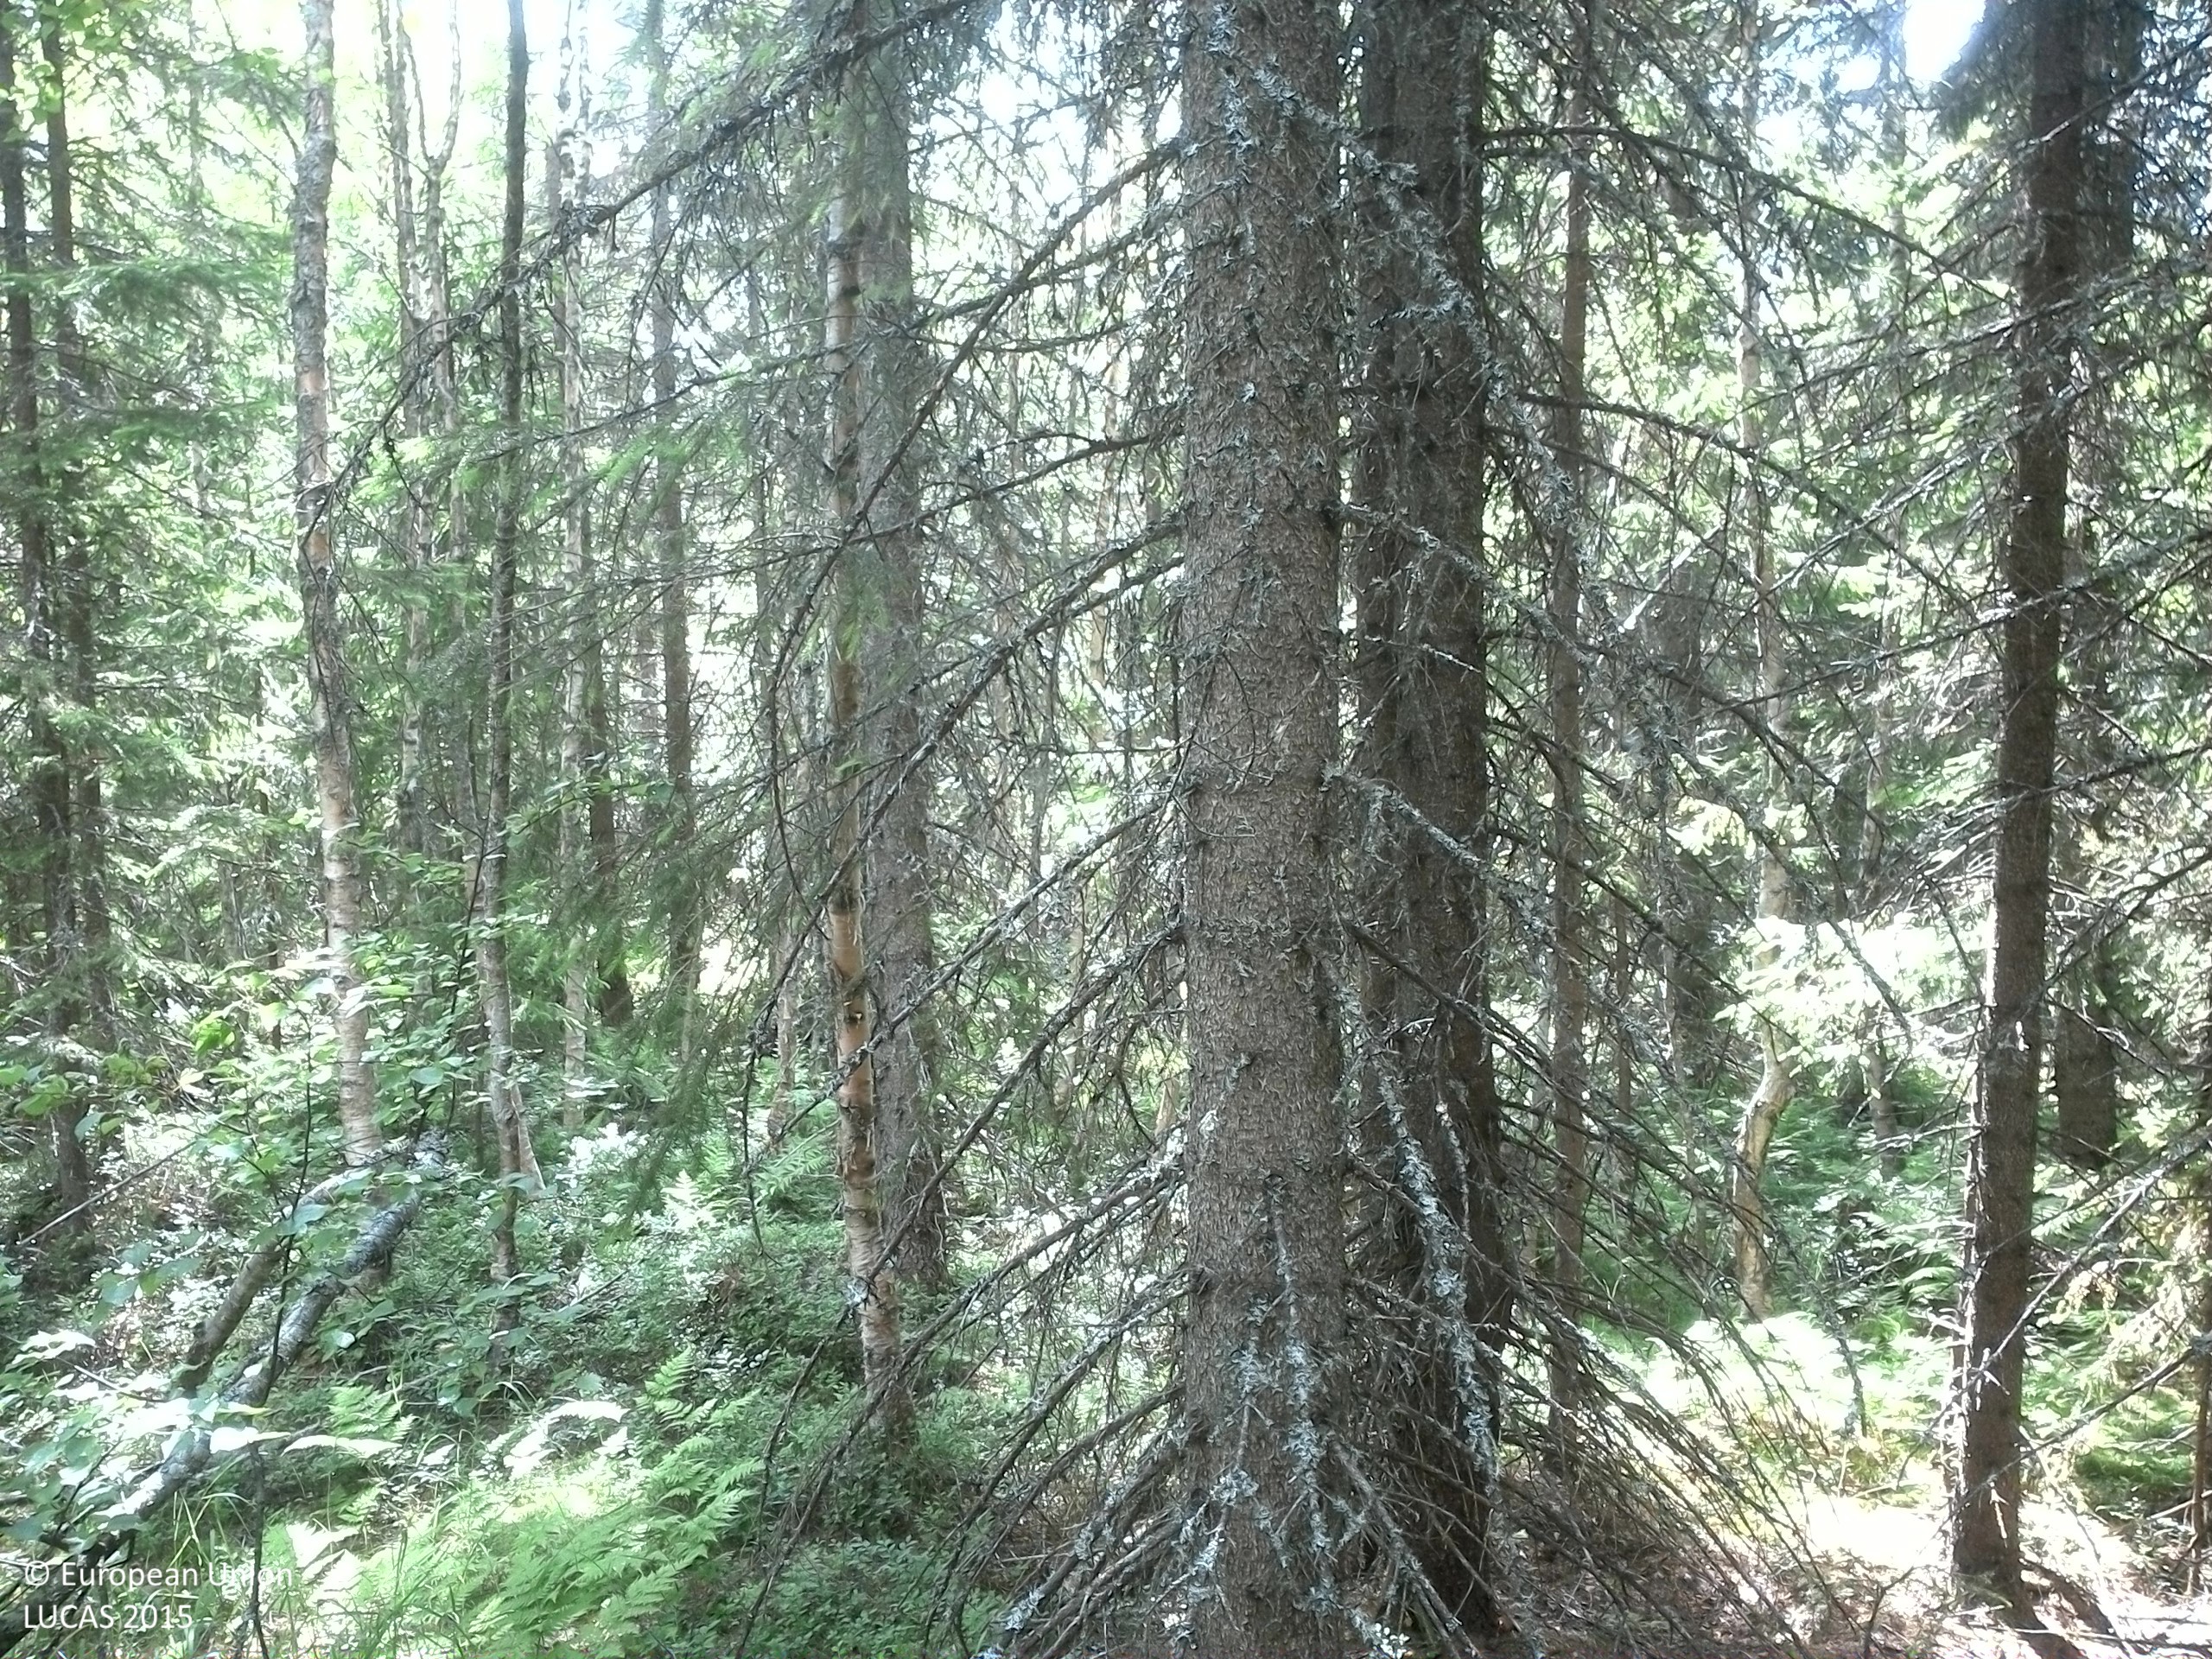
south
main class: Woodland
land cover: Spruce dominated mixed woodland
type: boreal forest
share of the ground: > 75 %
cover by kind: coniferous forest trees 50 %, broadleaved forest trees 25 %, shrubs 20 %, herbaceous plants 5 %
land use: Forestry
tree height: > 5 m
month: July
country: SE
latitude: 62.8166
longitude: 17.6502
